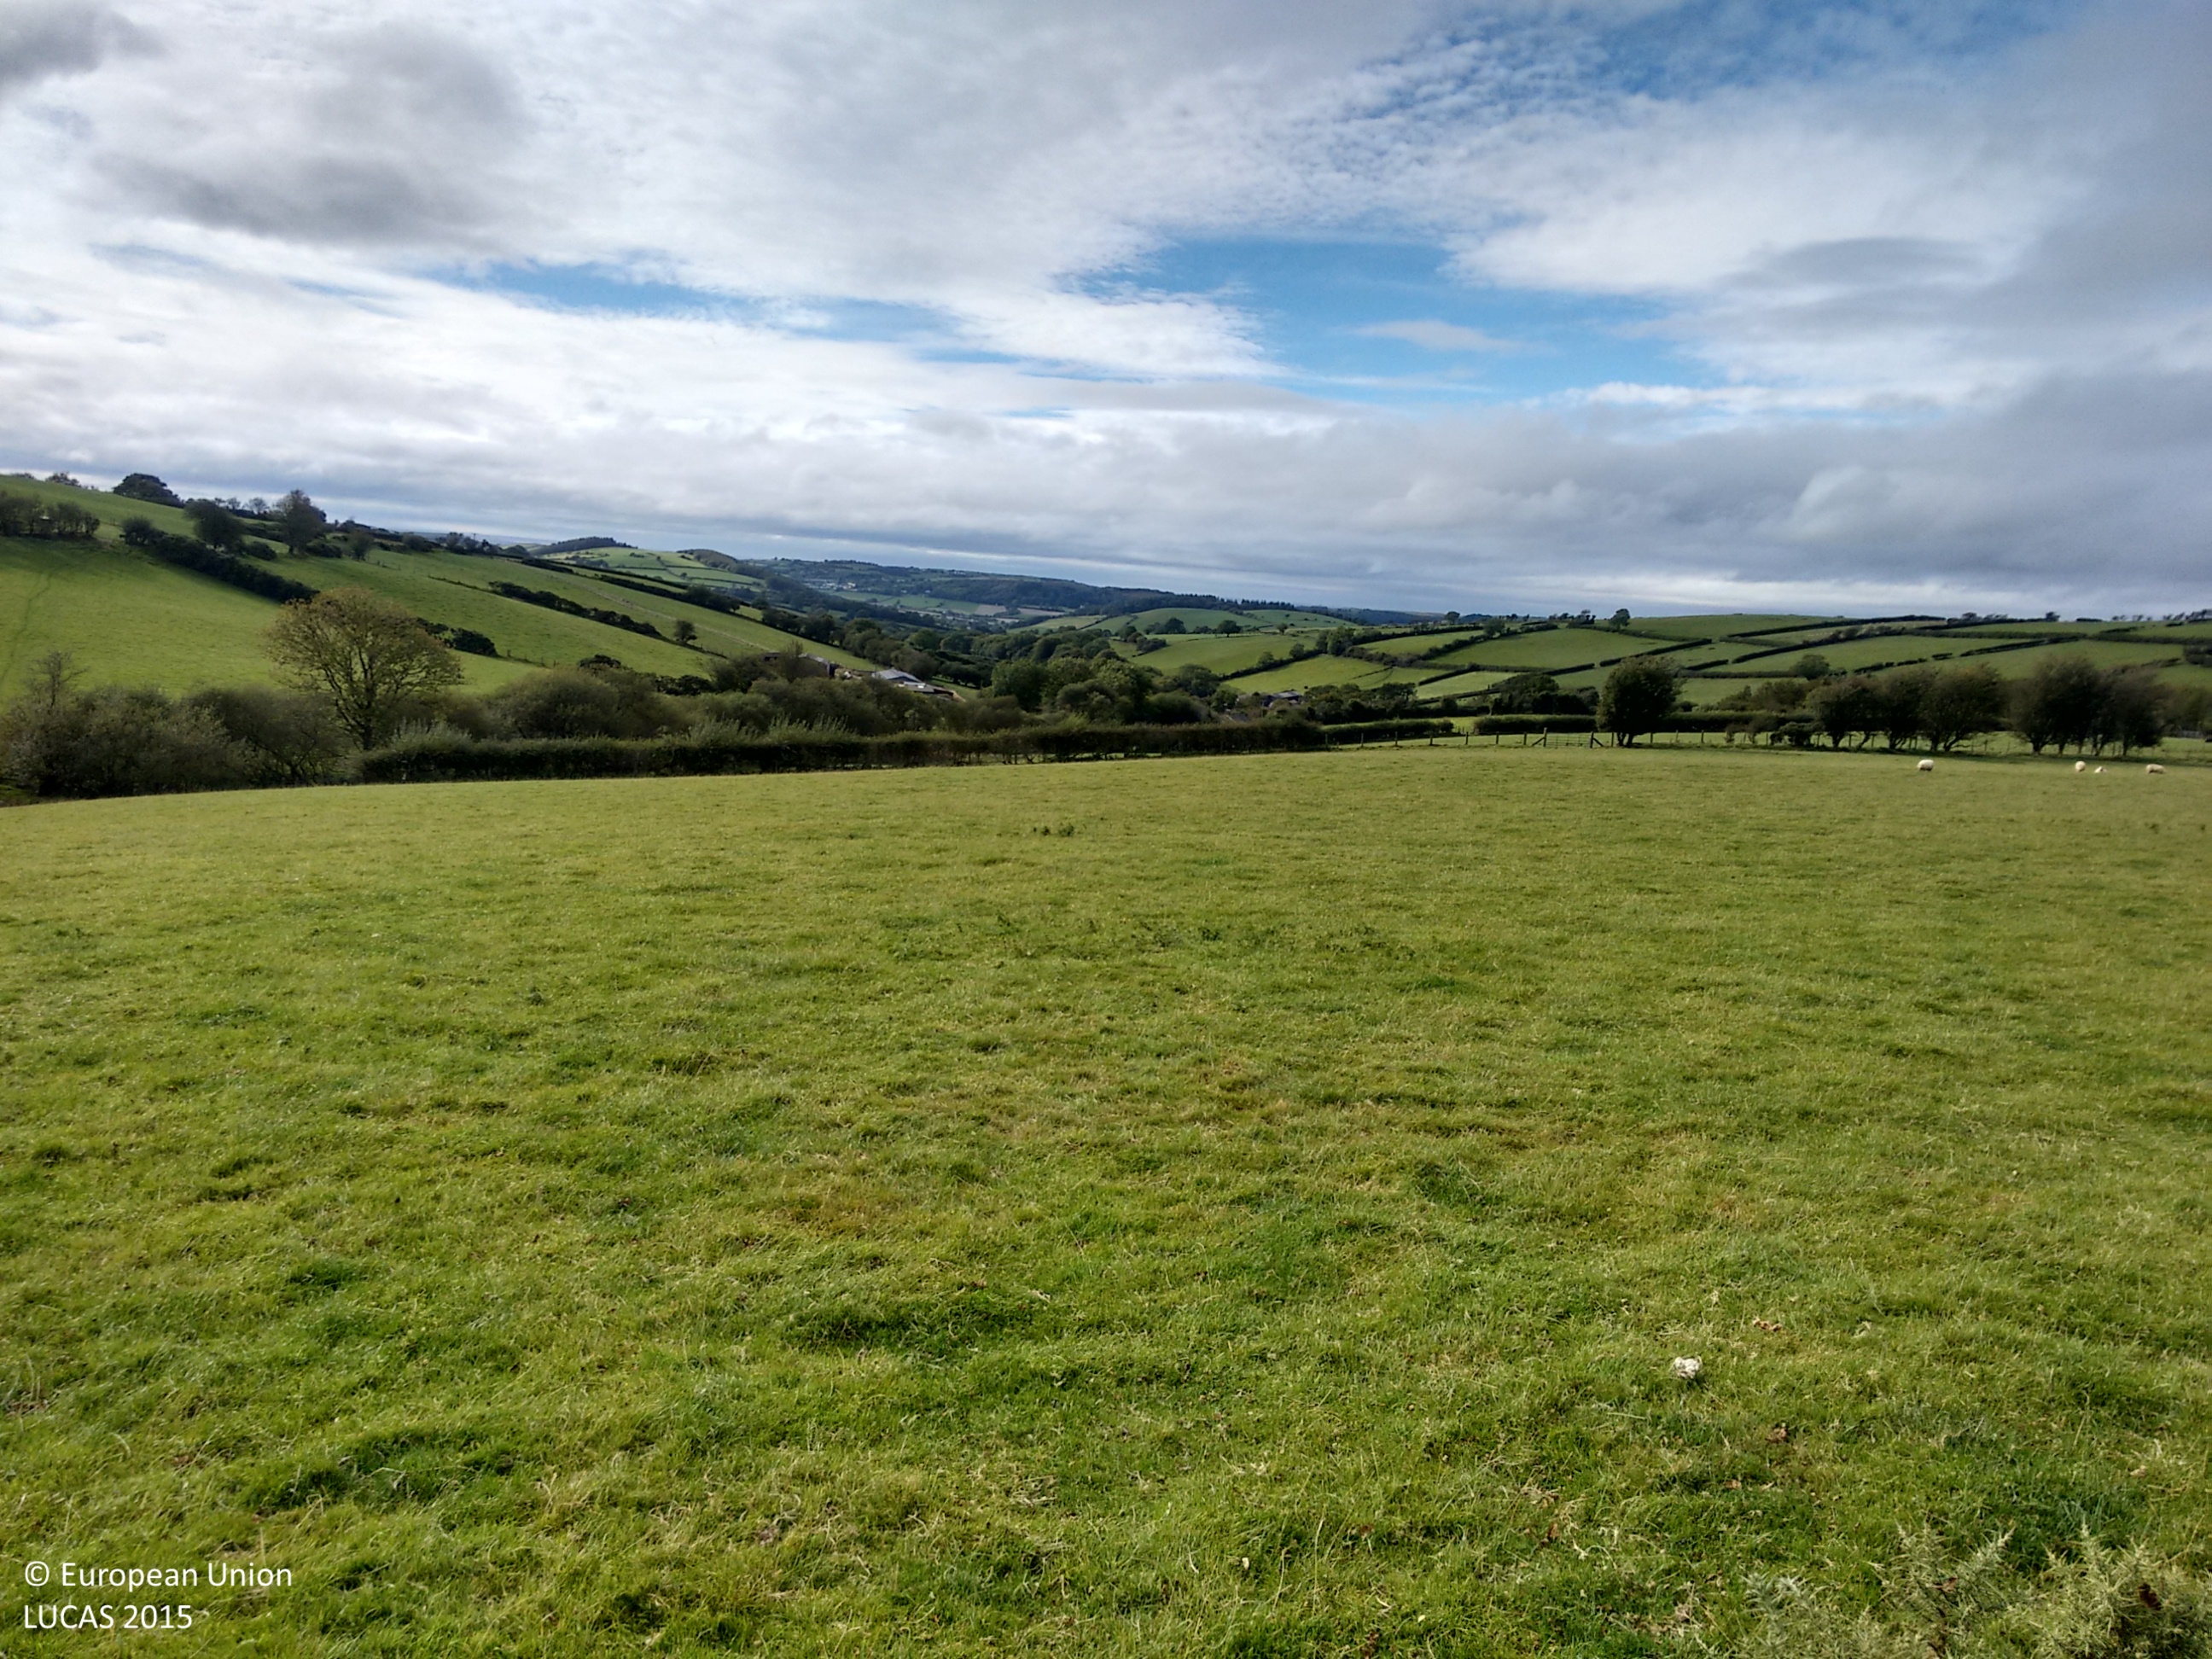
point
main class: Grassland
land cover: Grassland without tree/shrub cover
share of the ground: > 75 %
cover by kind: herbaceous plants 100 %
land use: Agriculture (excluding fallow land and kitchen gardens)
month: October
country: GB
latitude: 52.4235
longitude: -3.9607
